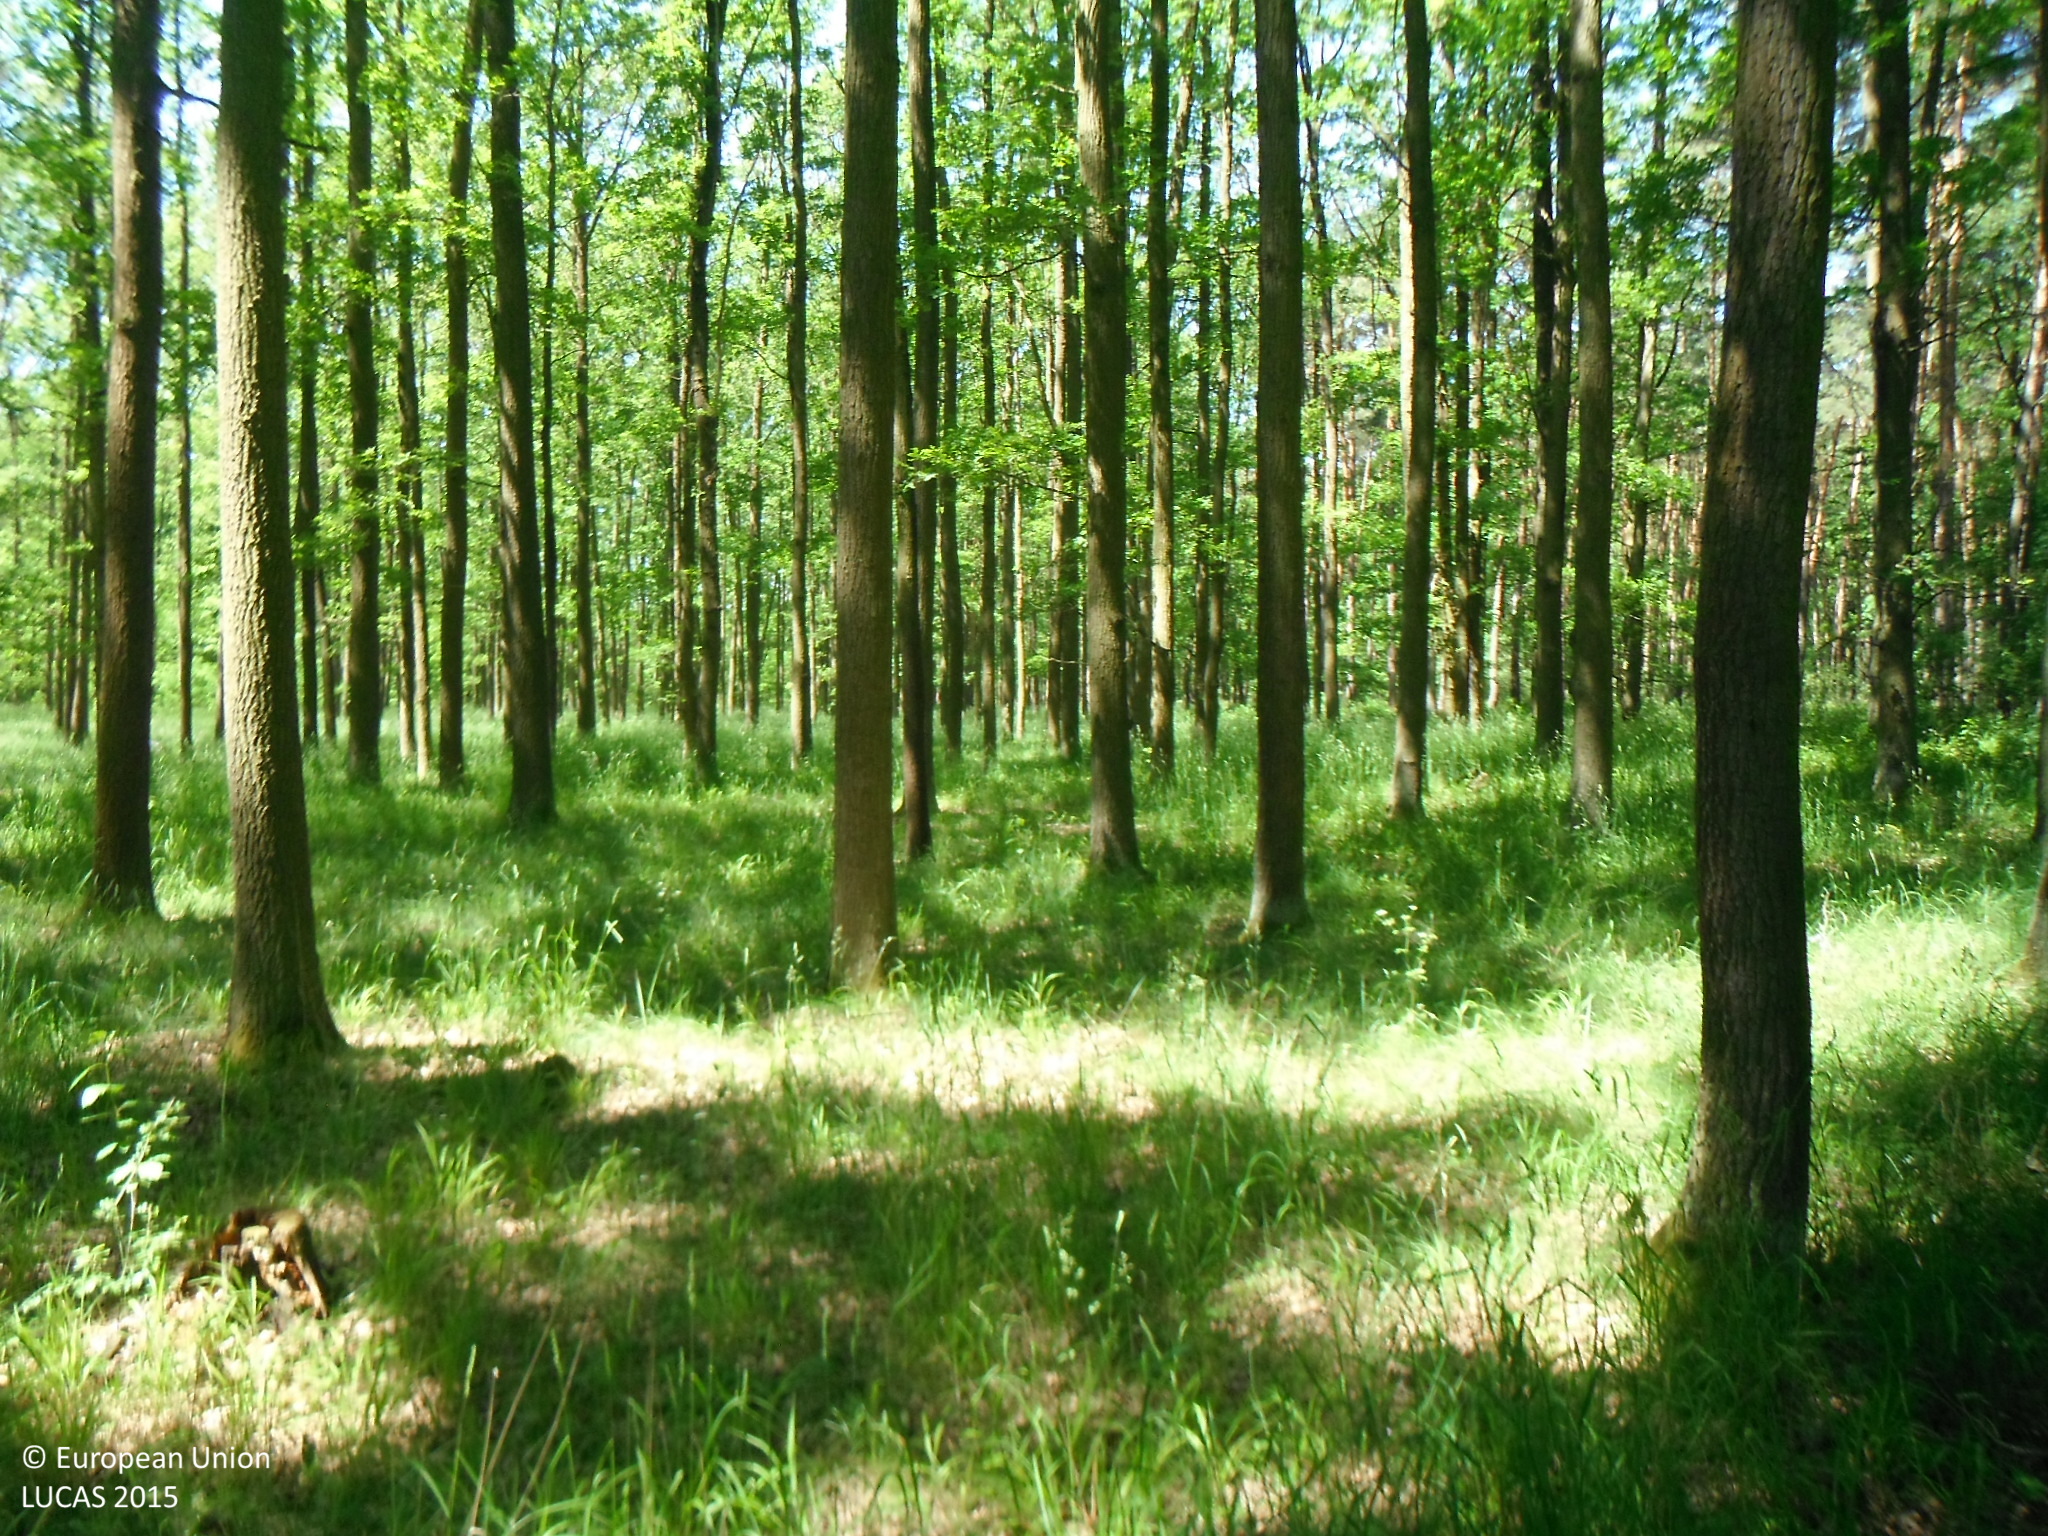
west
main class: Woodland
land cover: Broadleaved woodland
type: mesophytic deciduous forest
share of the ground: > 75 %
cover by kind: broadleaved forest trees 90 %, shrubs 5 %, herbaceous plants 5 %
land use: Forestry
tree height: > 5 m
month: June
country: SK
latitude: 48.7551
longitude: 17.0684
